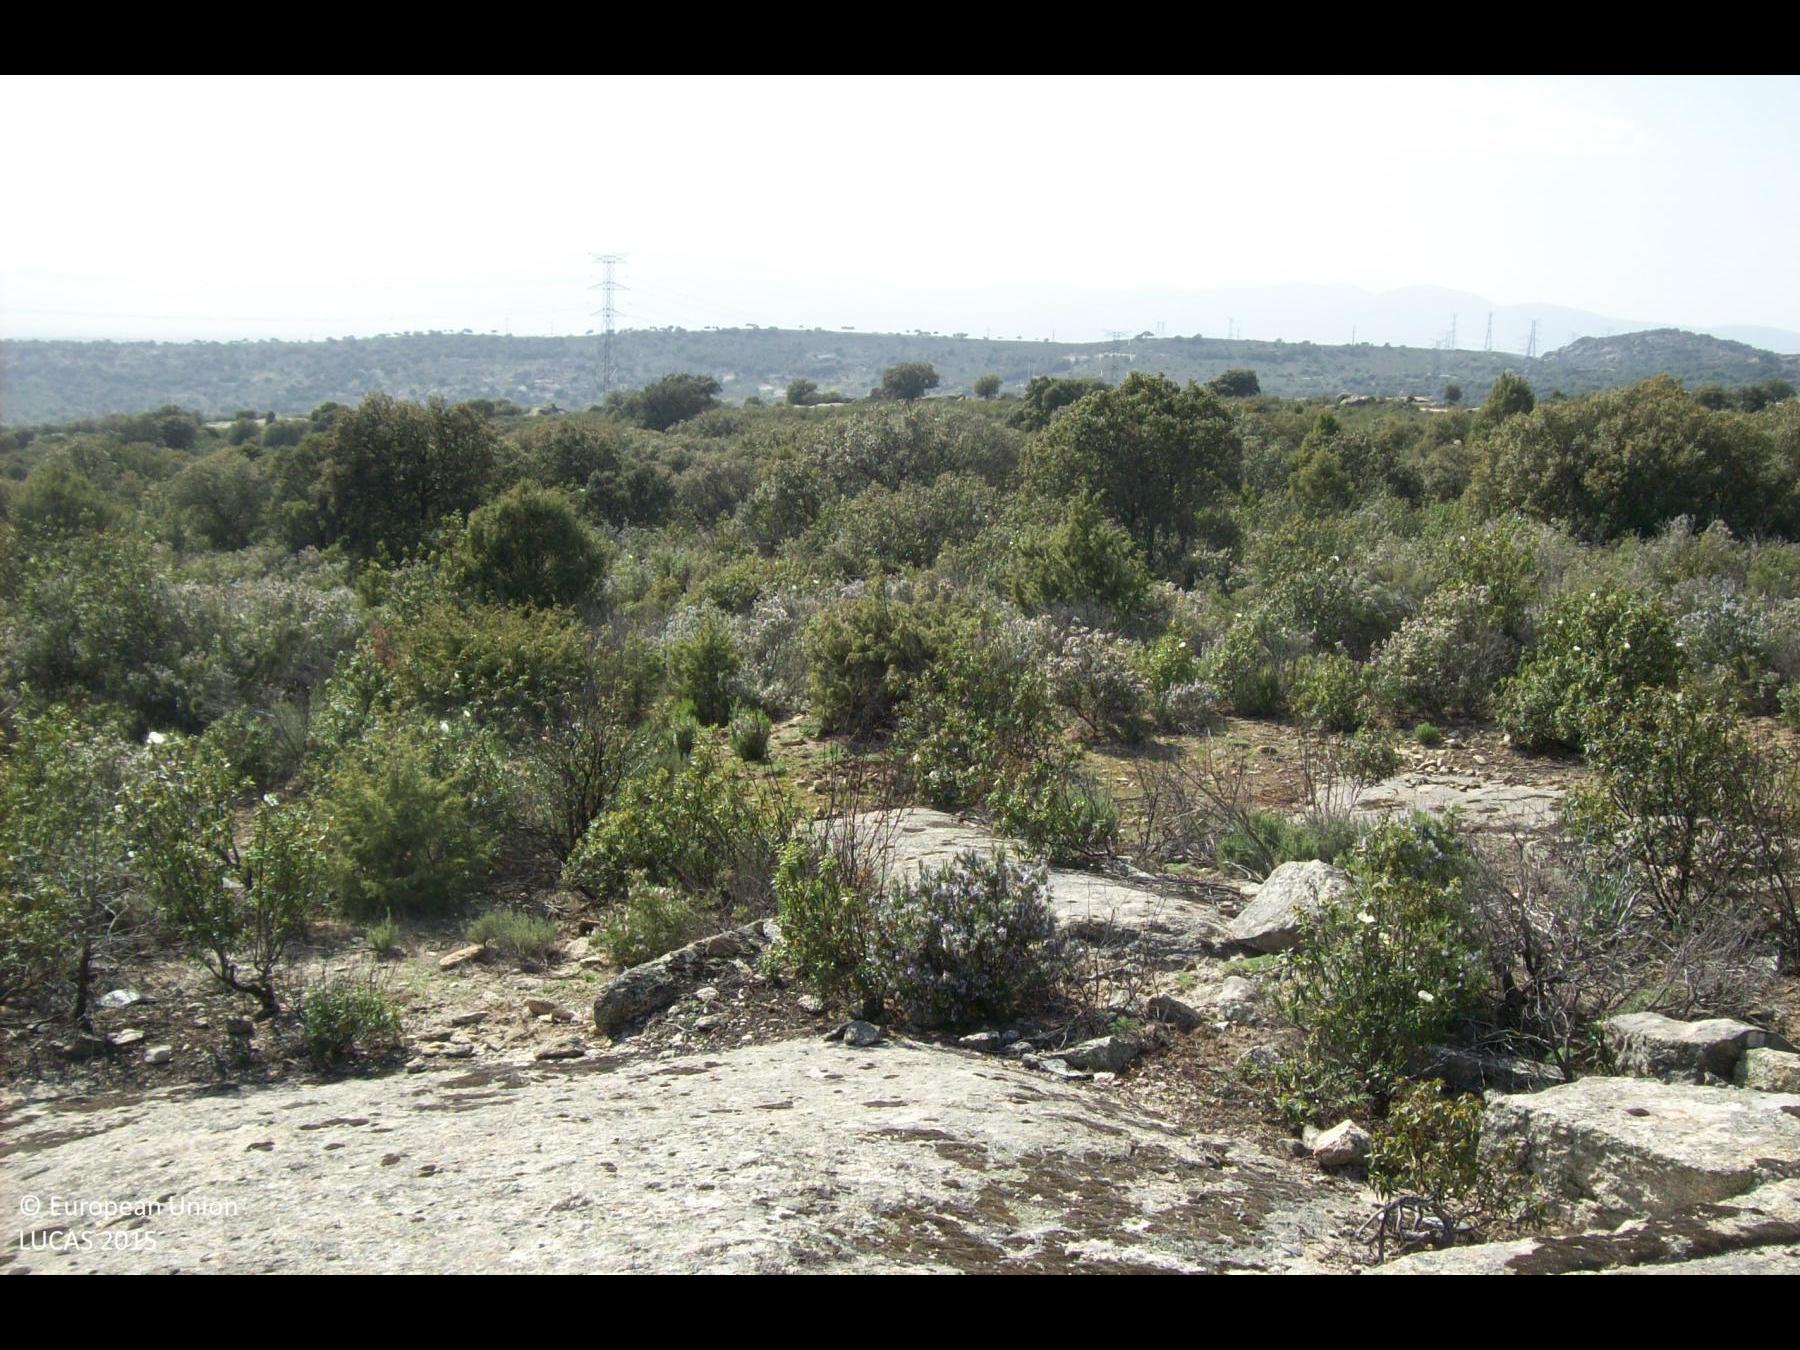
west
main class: Shrubland
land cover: Shrubland with sparse tree cover
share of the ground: 25 - 50 %
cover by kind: shrubs 45 %, consolidated bare surface 45 %, broadleaved forest trees 5 %, herbaceous plants 5 %
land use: Semi-natural and natural areas not in use
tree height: < 5 m
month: April
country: ES
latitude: 40.6237
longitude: -3.9337
